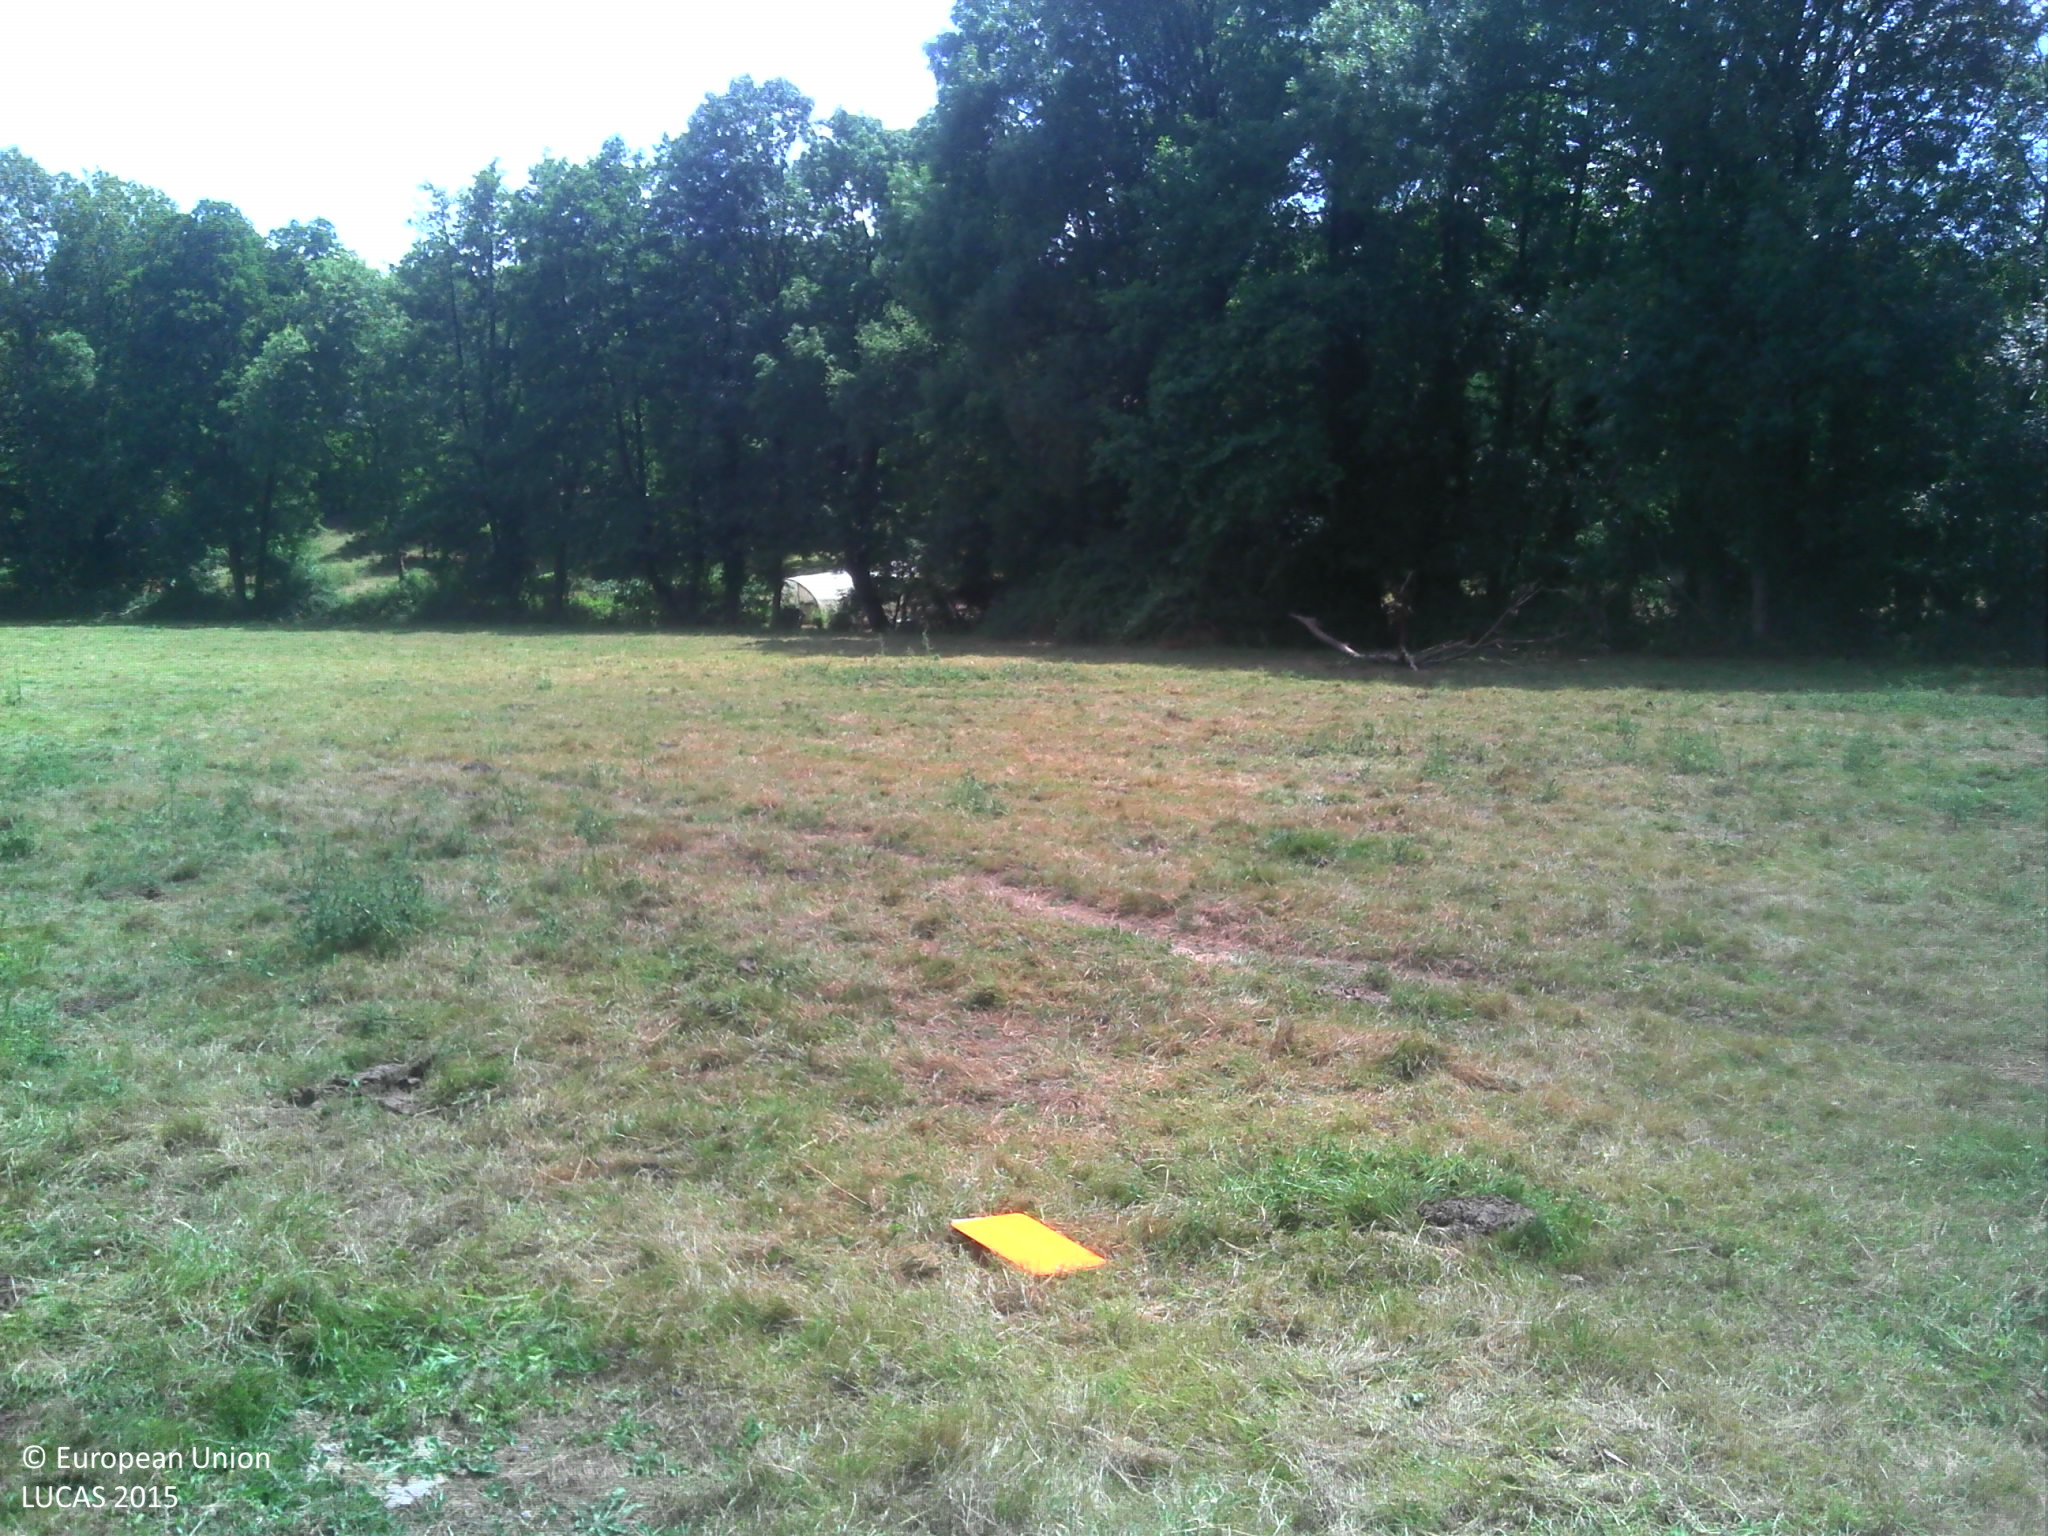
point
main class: Grassland
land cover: Grassland without tree/shrub cover
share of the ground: > 75 %
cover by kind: herbaceous plants 100 %
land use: Agriculture (excluding fallow land and kitchen gardens)
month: July
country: FR
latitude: 46.5074
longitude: -1.3609
